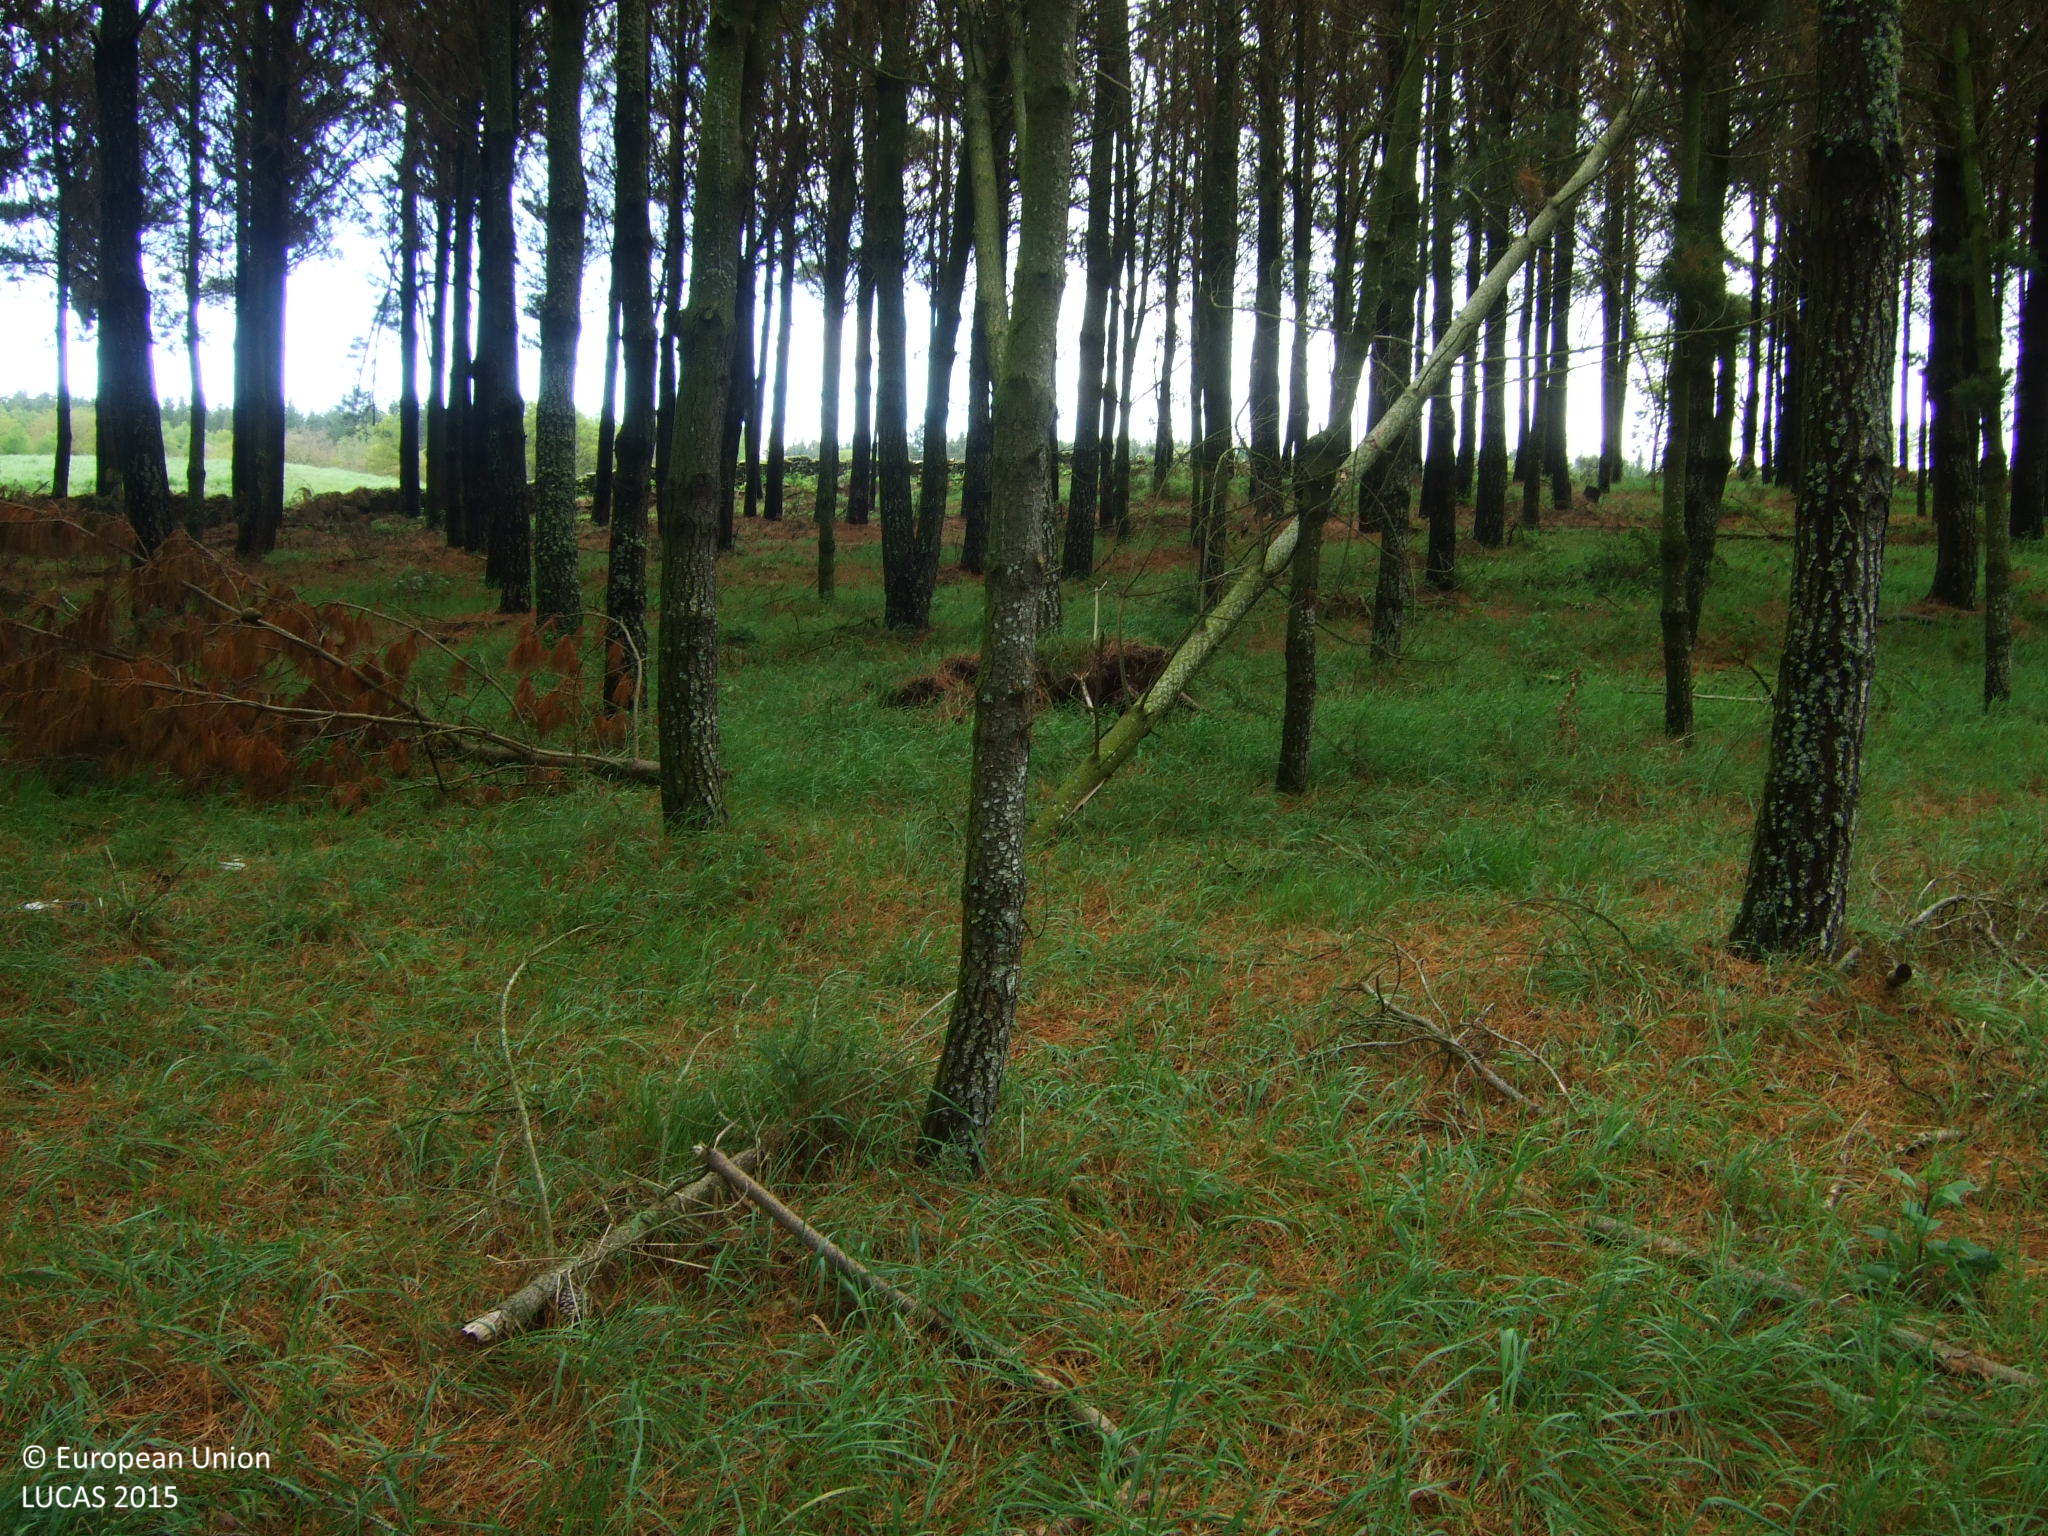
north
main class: Woodland
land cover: Pine dominated coniferous woodland
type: exotic forest
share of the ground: 50 - 75 %
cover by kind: coniferous forest trees 65 %, herbaceous plants 25 %, shrubs 5 %, unconsolidated bare surface 5 %
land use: Forestry
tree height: > 5 m
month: May
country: ES
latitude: 42.7906
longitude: -7.5189
